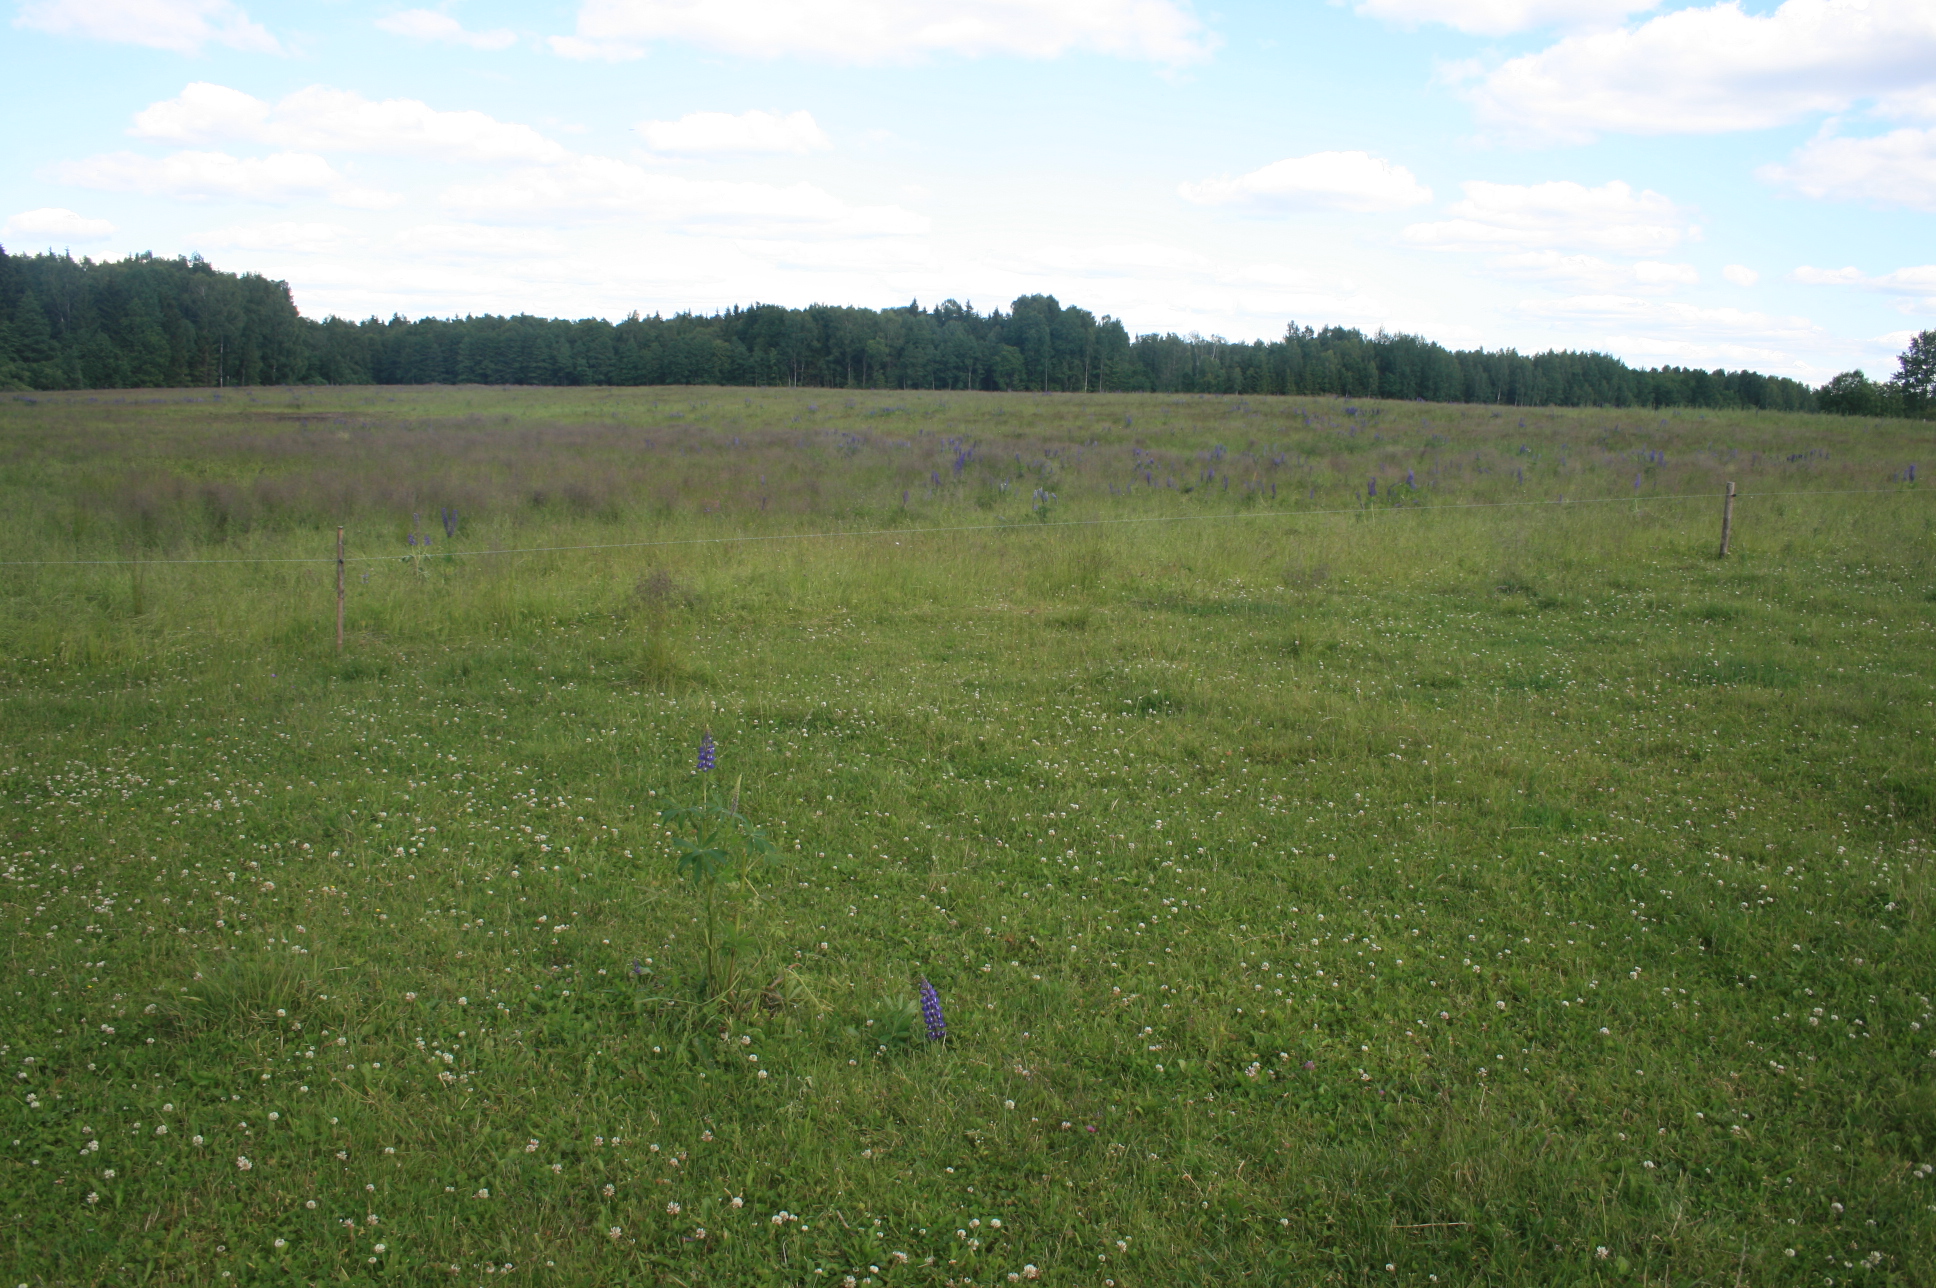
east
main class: Grassland
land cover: Grassland without tree/shrub cover
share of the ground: > 75 %
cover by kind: herbaceous plants 100 %
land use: Agriculture (excluding fallow land and kitchen gardens)
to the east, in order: Grassland without tree/shrub cover; Fences; Grassland without tree/shrub cover
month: June
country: LT
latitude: 55.4234
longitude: 22.1746
